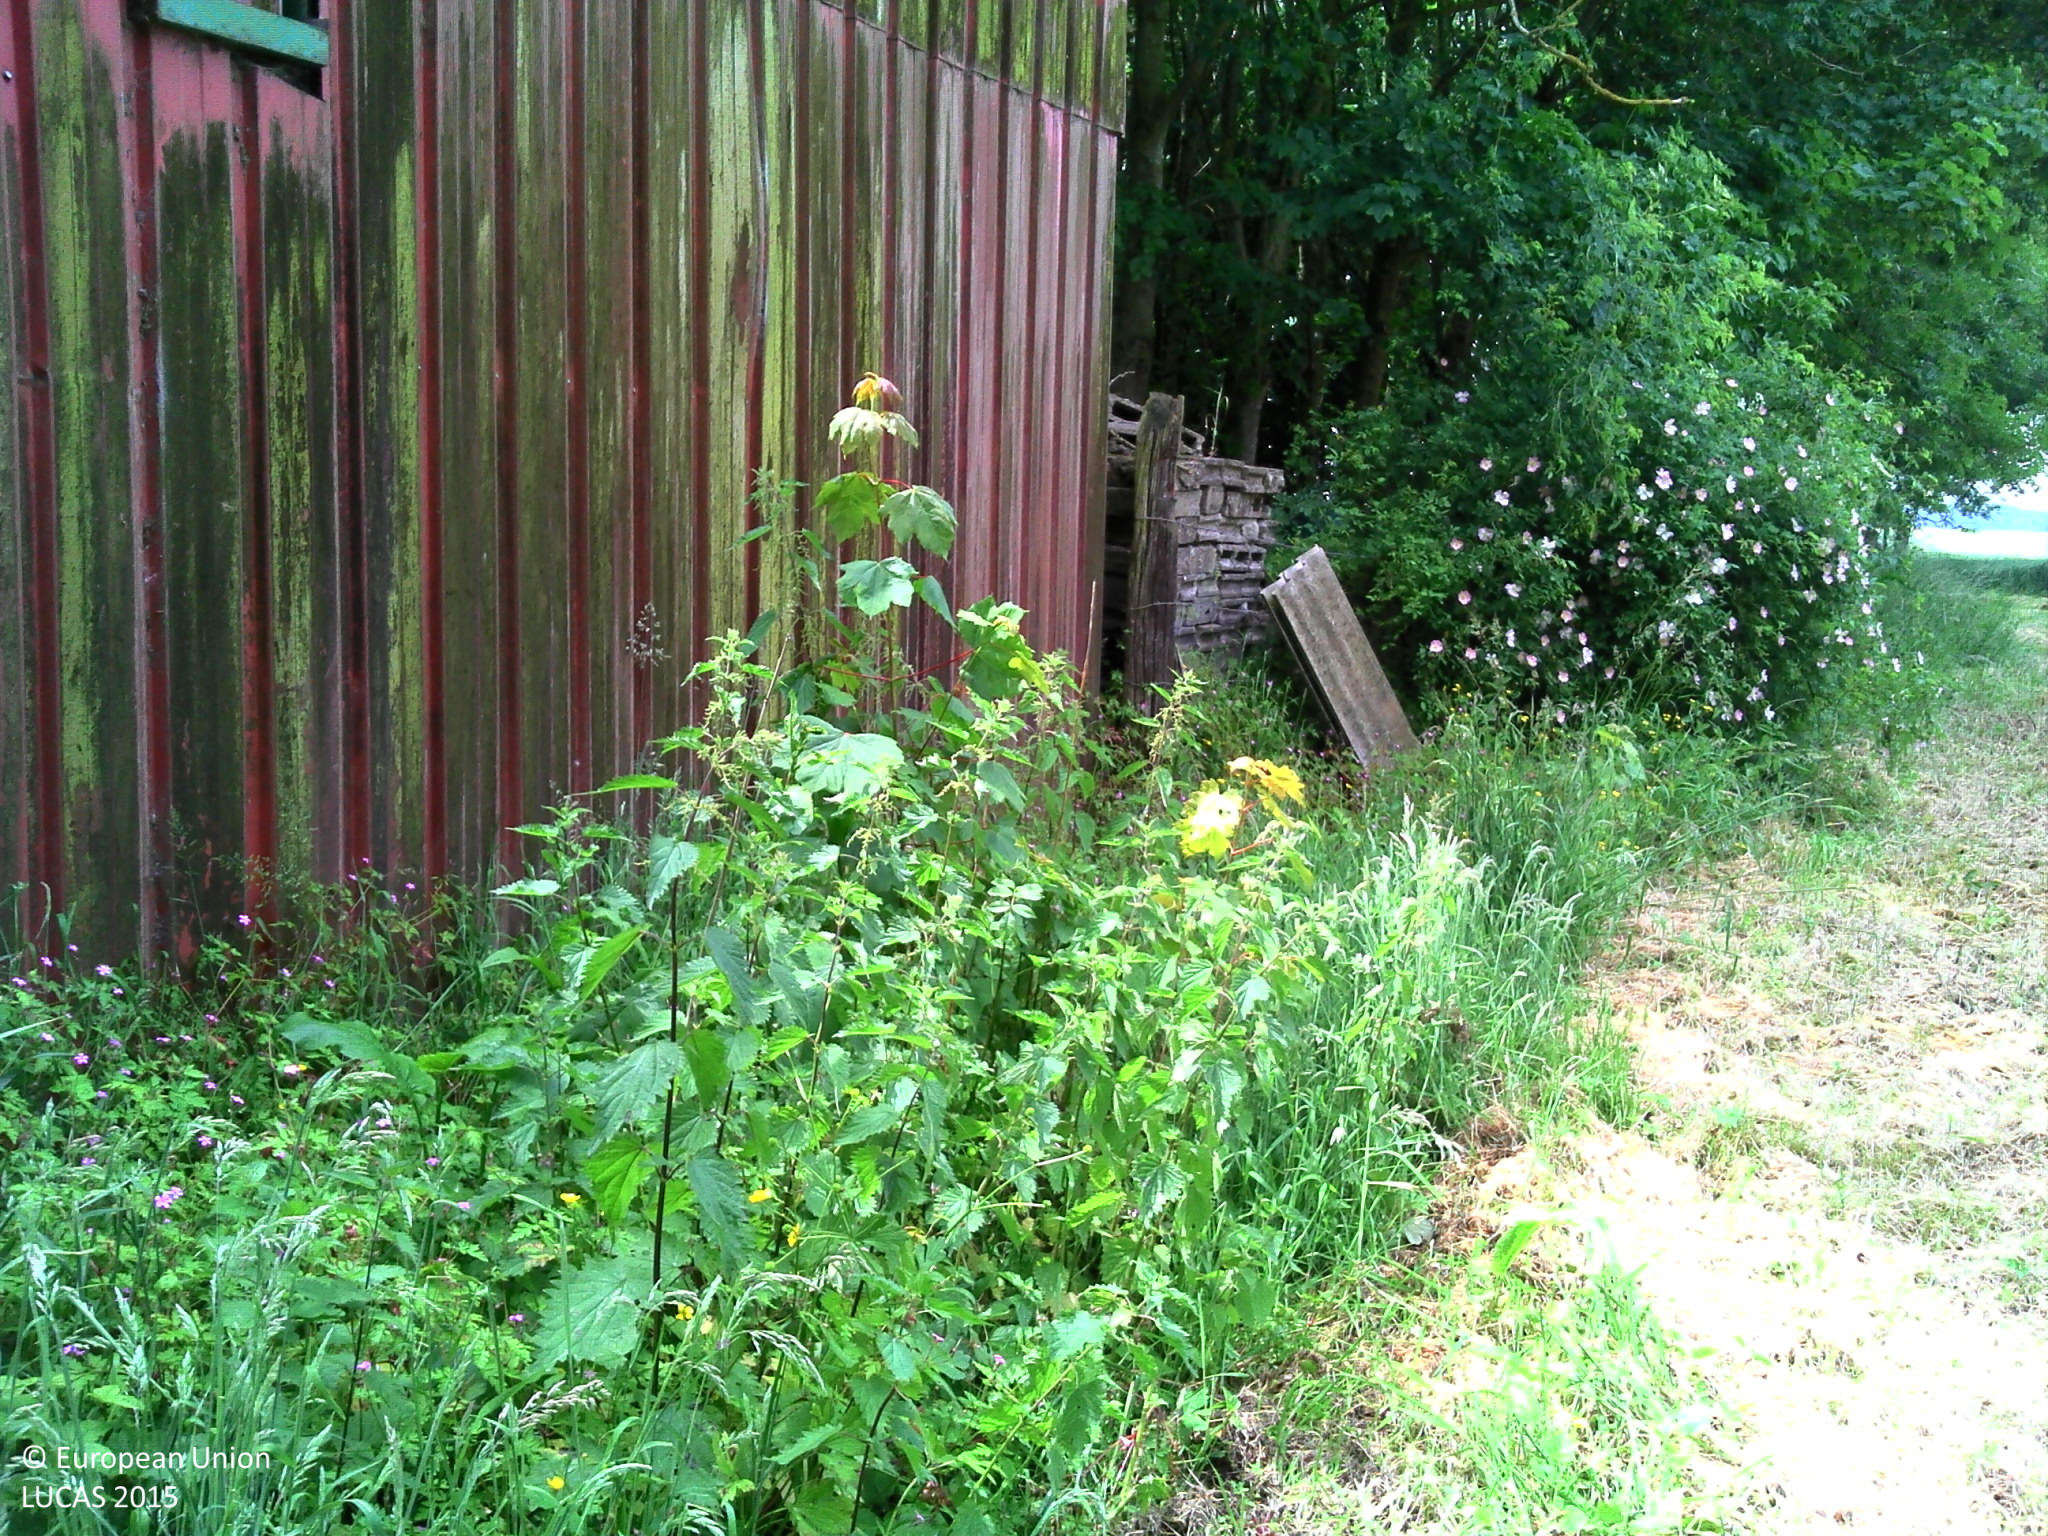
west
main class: Grassland
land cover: Grassland without tree/shrub cover
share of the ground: > 75 %
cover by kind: herbaceous plants 80 %
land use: Semi-natural and natural areas not in use
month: June
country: FR
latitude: 50.5112
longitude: 2.4426
